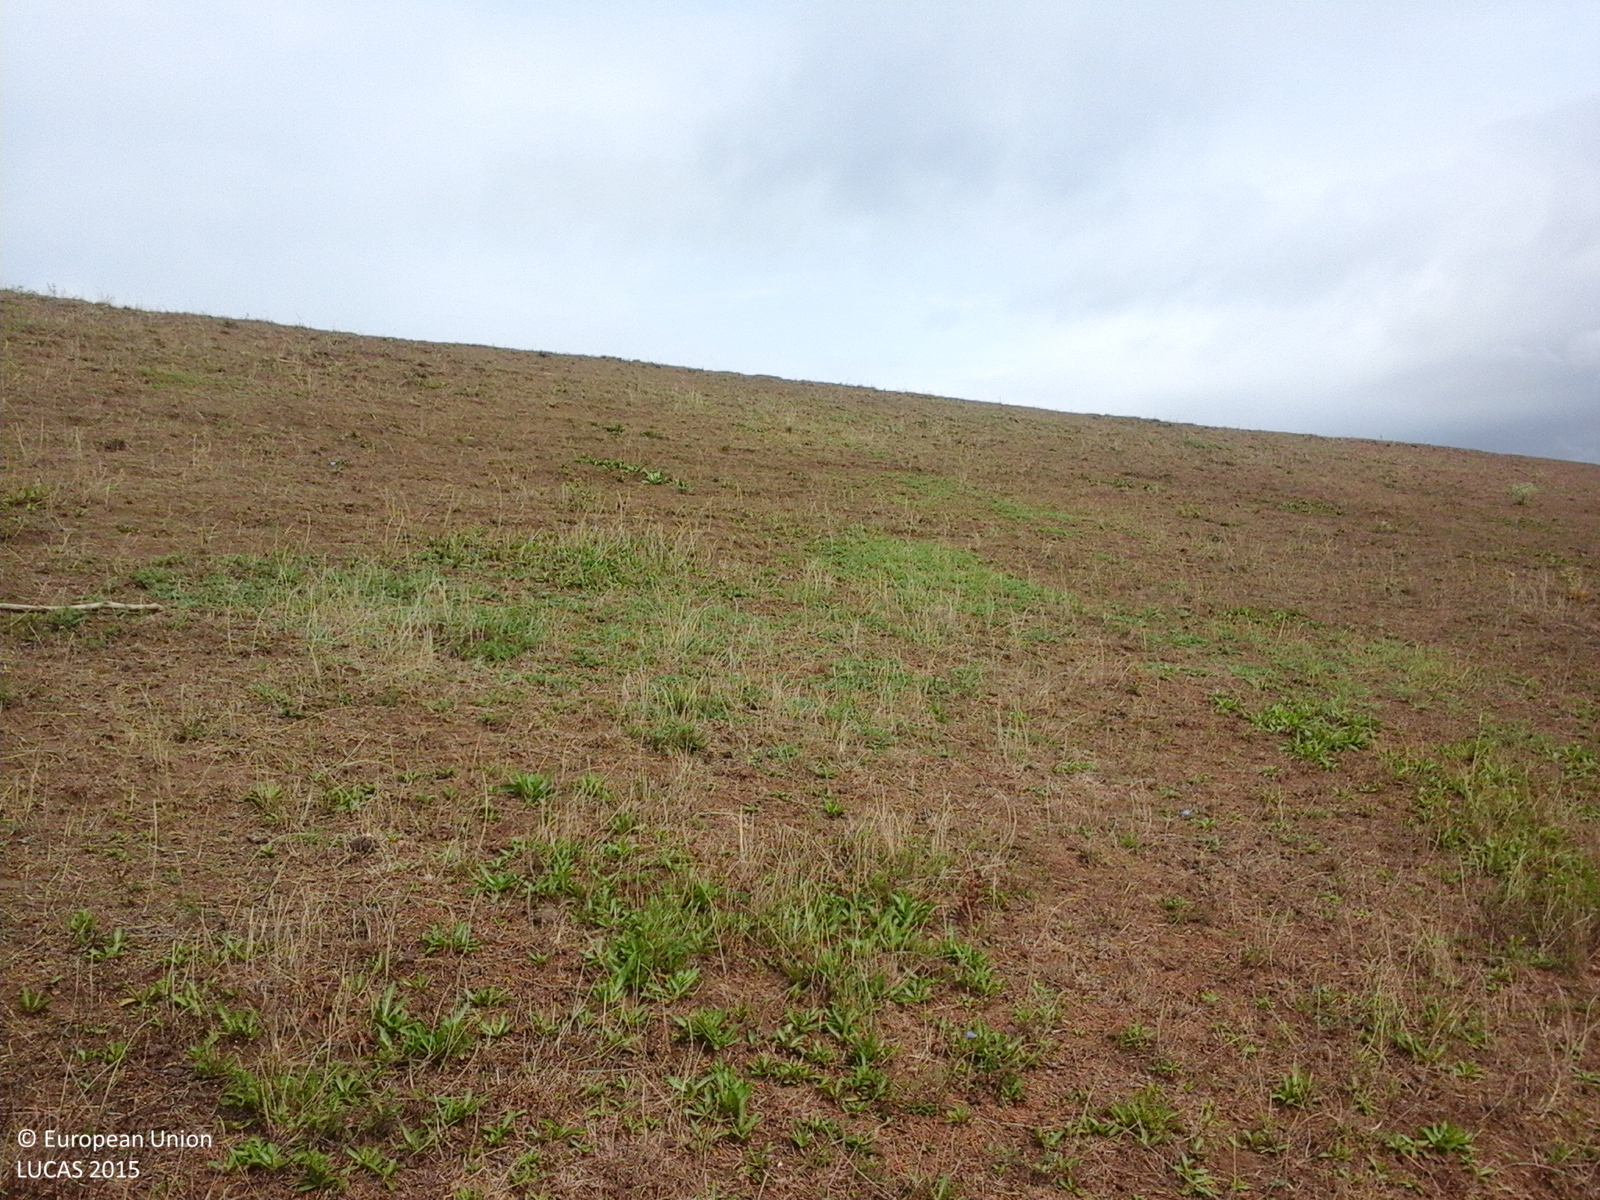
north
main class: Grassland
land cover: Grassland without tree/shrub cover
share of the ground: > 75 %
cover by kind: herbaceous plants 100 %
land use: Agriculture (excluding fallow land and kitchen gardens)
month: August
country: RO
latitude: 45.5250
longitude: 21.0251
